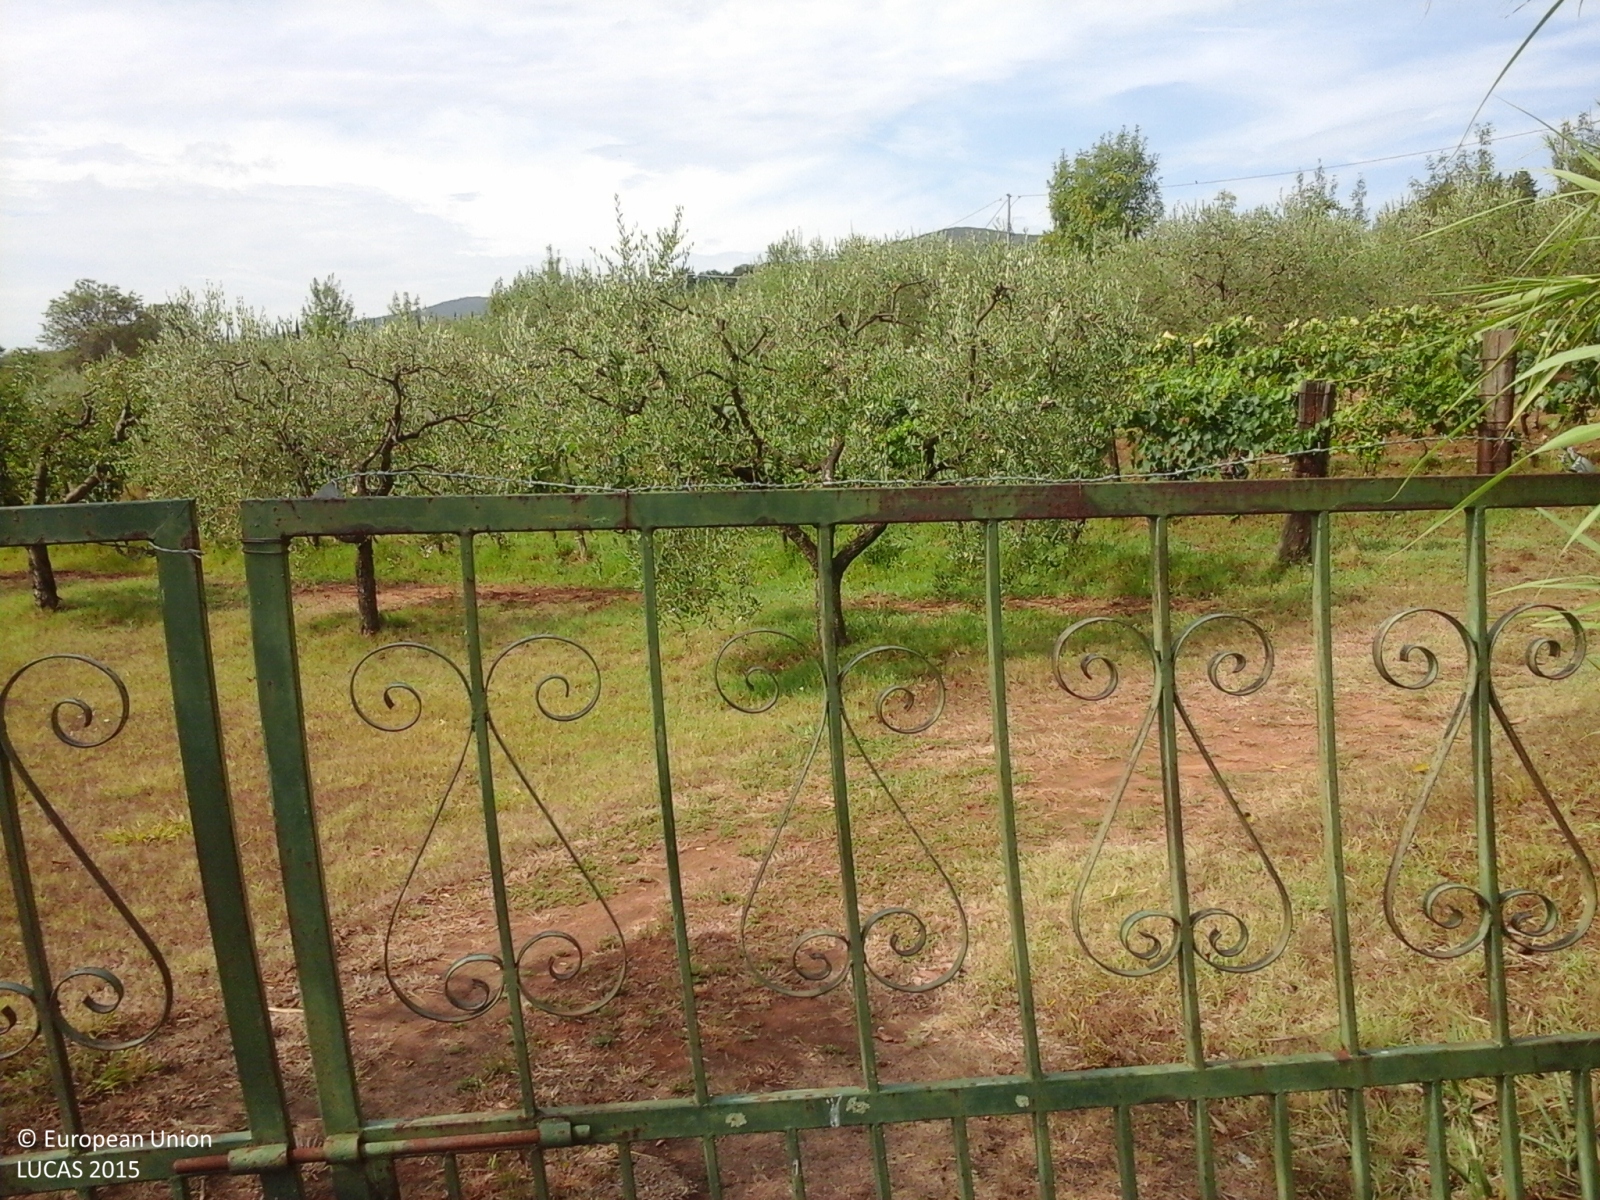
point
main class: Cropland
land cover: Olive groves
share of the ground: 50 - 75 %
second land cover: Grassland without tree/shrub cover
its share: 10 - 25 %
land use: Agriculture (excluding fallow land and kitchen gardens)
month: August
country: IT
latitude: 42.9386
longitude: 10.9406
